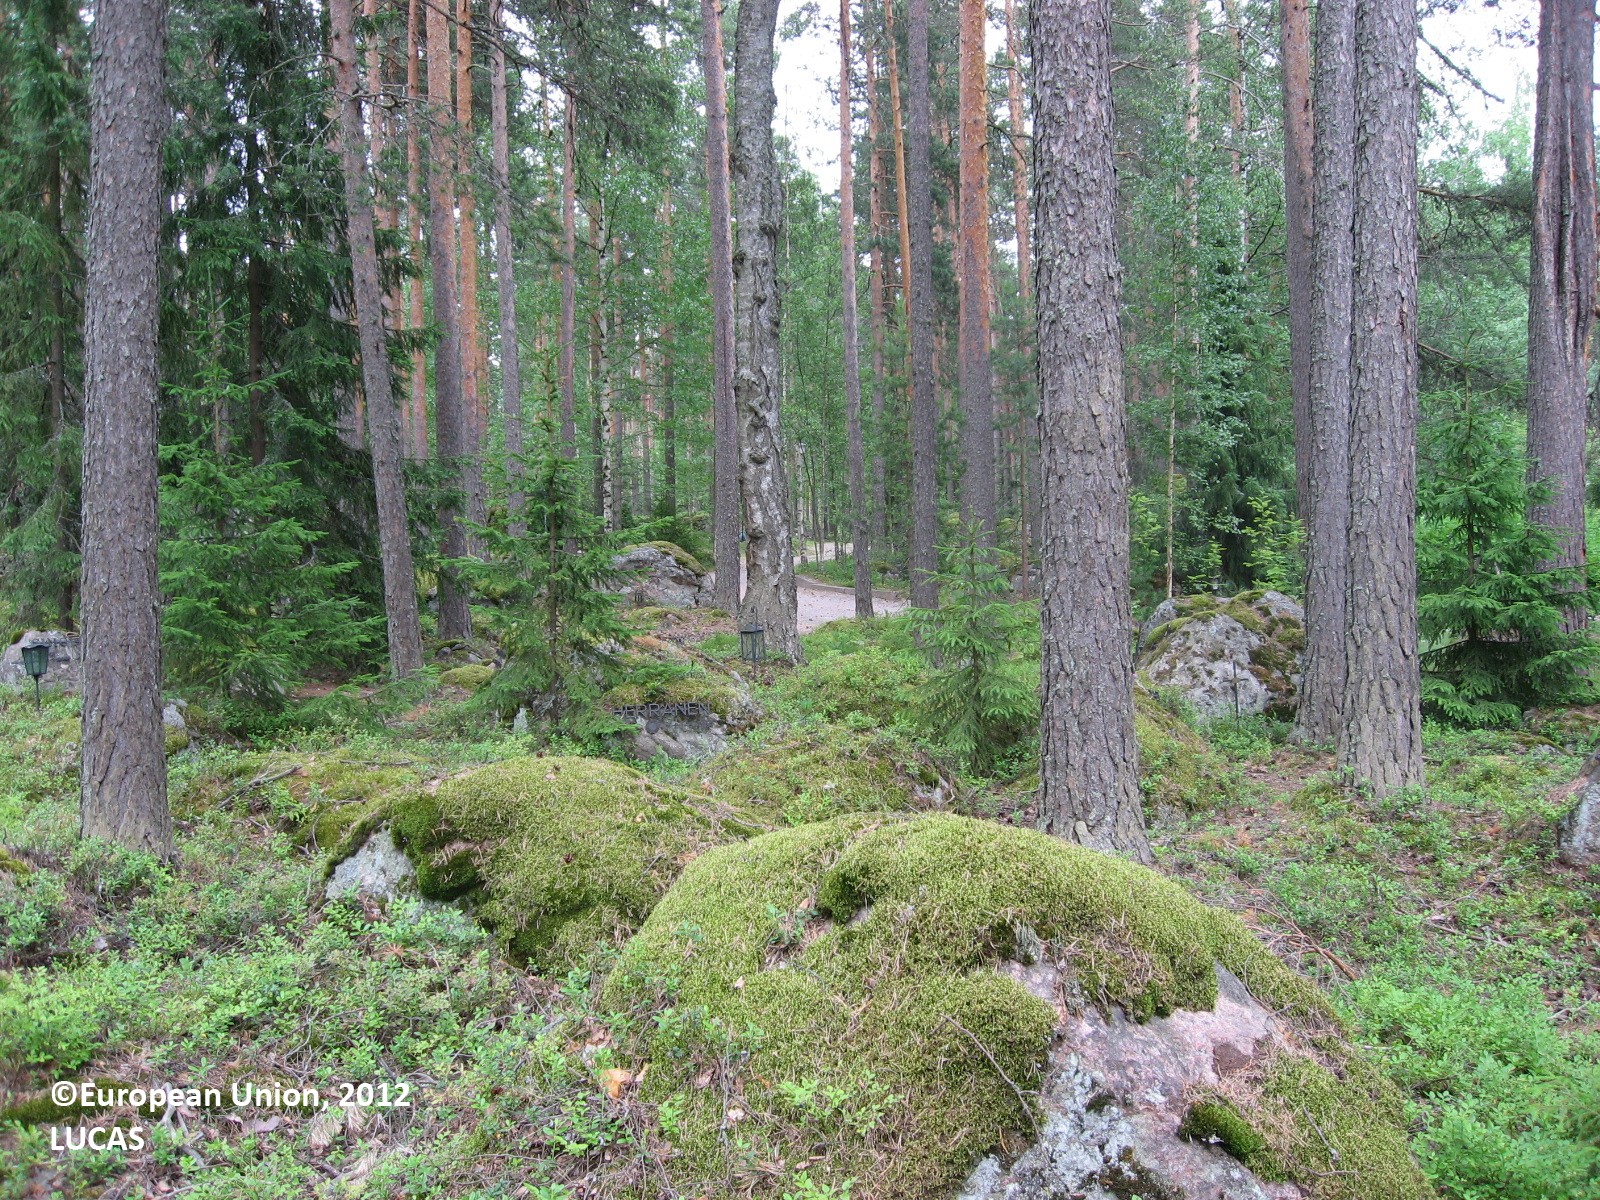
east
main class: Woodland
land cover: Pine dominated coniferous woodland
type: boreal forest
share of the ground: 50 - 75 %
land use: Community services
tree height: > 5 m
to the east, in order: Pine dominated coniferous woodland; Tracks; Pine dominated coniferous woodland; Tracks; Spruce dominated mixed woodland; Artificial constructions in urban areas; Pine dominated coniferous woodland; Broadleaved woodland; Electric lines; Broadleaved woodland; Pine dominated coniferous woodland; Spruce dominated coniferous woodland
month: July
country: FI
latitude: 60.9650
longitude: 25.7392
